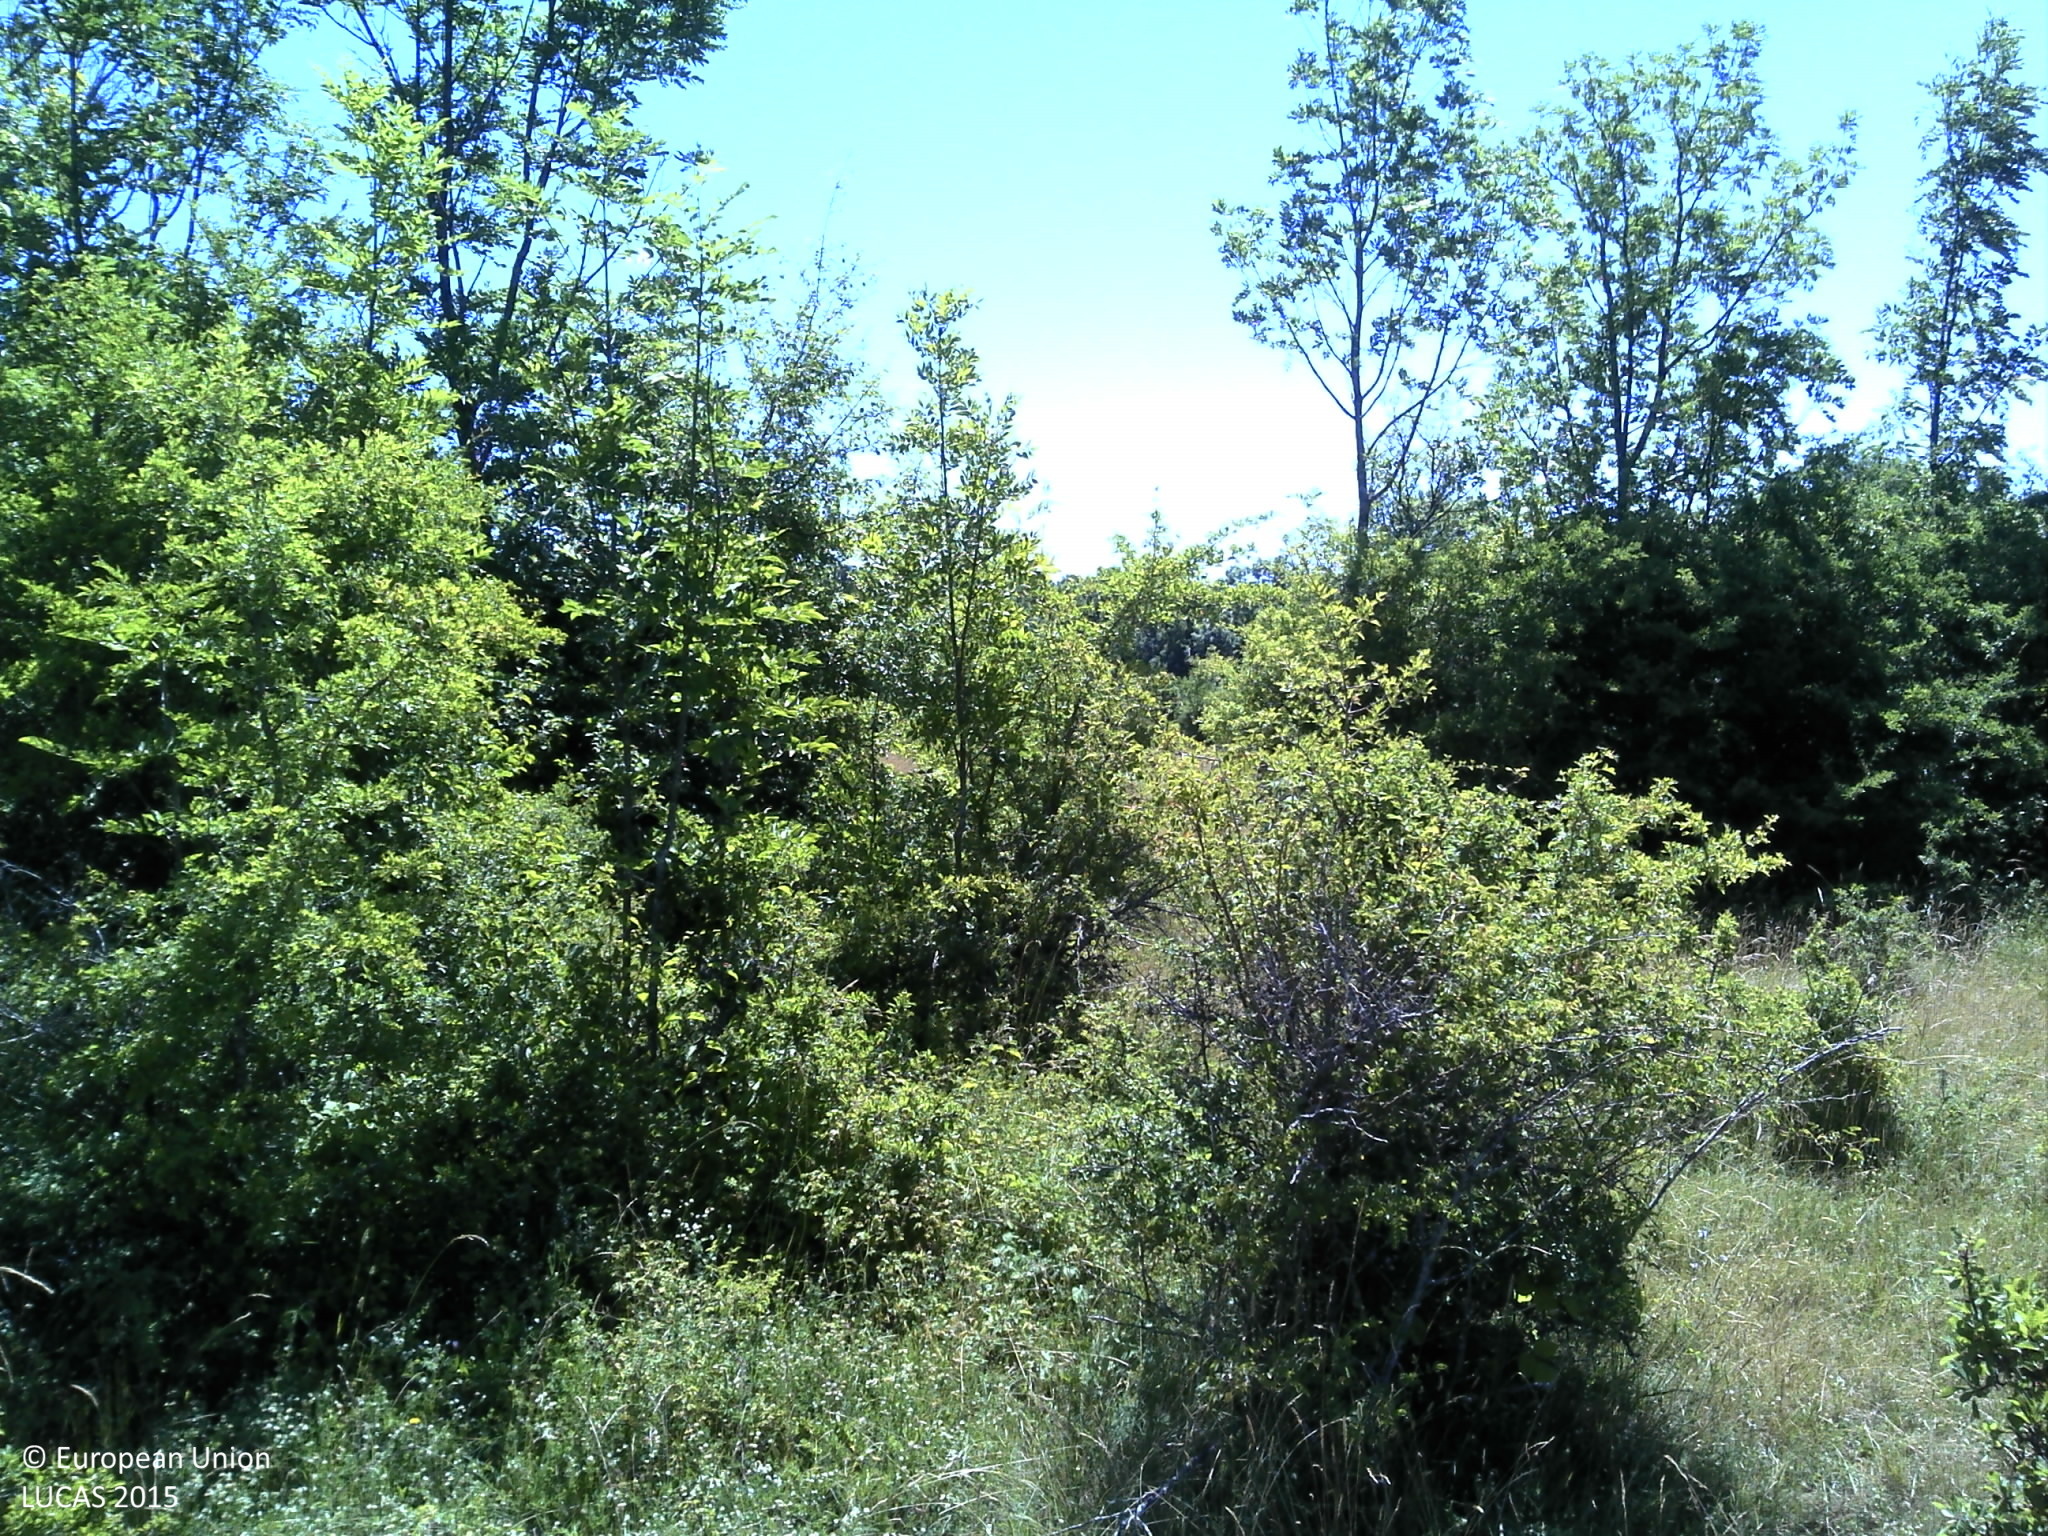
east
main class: Shrubland
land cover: Shrubland with sparse tree cover
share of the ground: 25 - 50 %
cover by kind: herbaceous plants 55 %, shrubs 40 %, broadleaved forest trees 5 %
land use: Semi-natural and natural areas not in use
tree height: < 5 m
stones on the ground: < 10 %
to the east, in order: Shrubland with sparse tree cover; Grassland with sparse tree/shrub cover; Dry stone walls; Grassland with sparse tree/shrub cover; Fences; Other fruit trees and berries
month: July
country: HR
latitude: 44.4006
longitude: 15.8820
